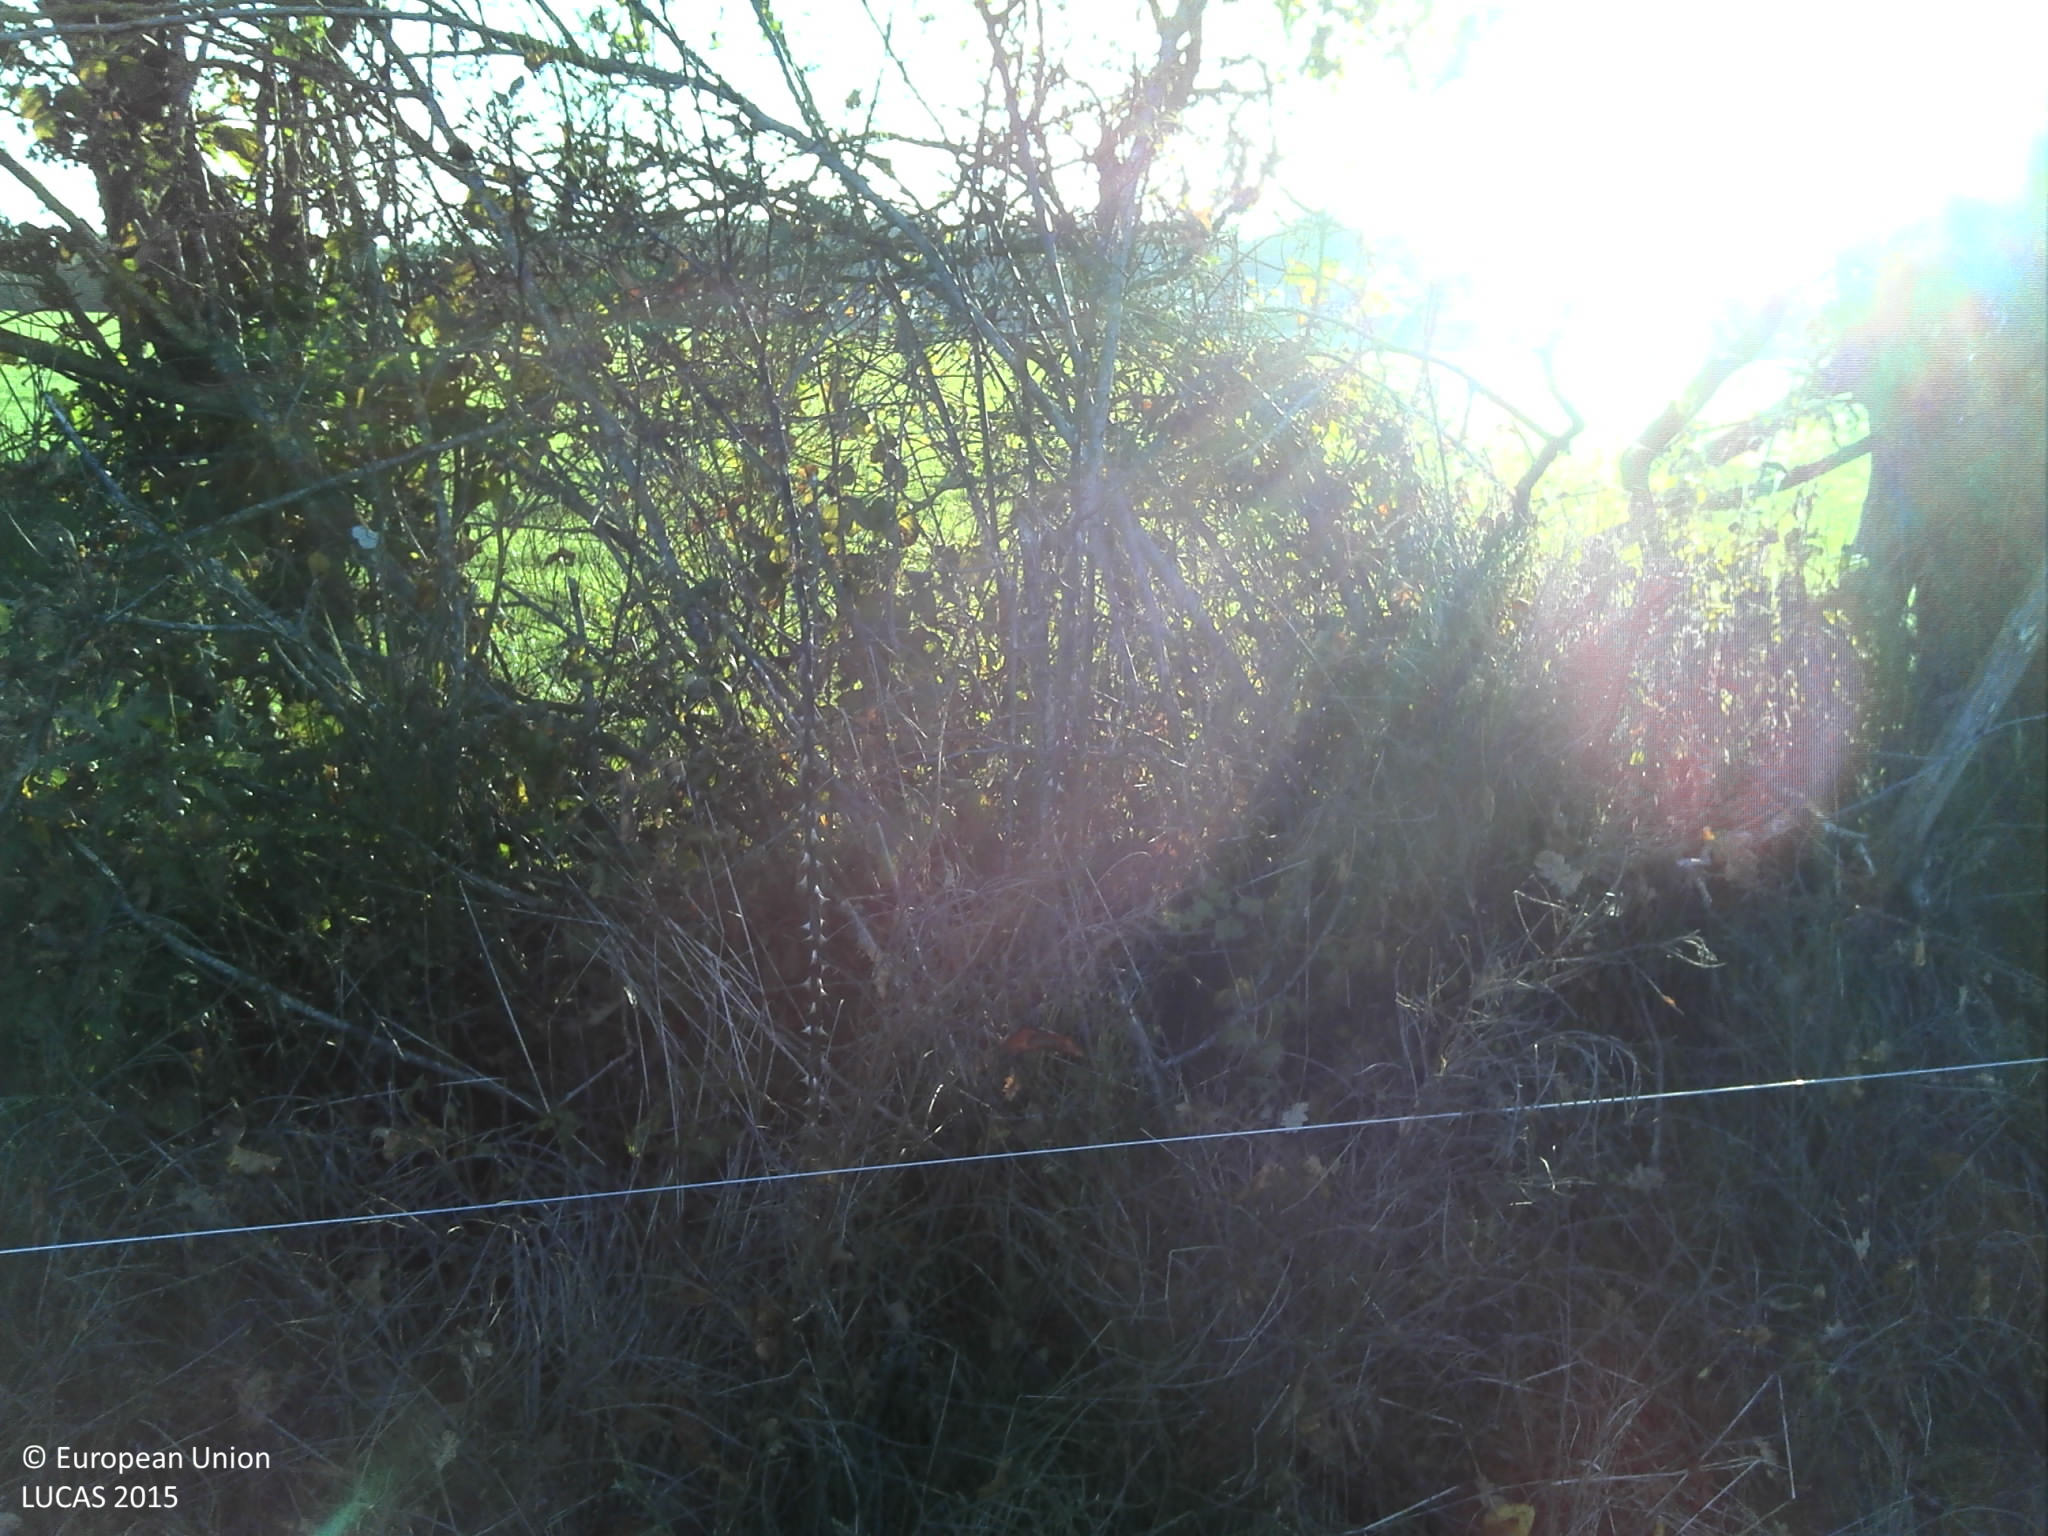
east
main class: Grassland
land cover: Grassland with sparse tree/shrub cover
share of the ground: > 75 %
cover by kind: herbaceous plants 95 %, broadleaved forest trees 5 %
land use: Agriculture (excluding fallow land and kitchen gardens)
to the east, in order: Grassland with sparse tree/shrub cover; Fences; Abandoned hedges; Temporary grasslands; Fences; Broadleaved woodland
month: November
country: FR
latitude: 47.5923
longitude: -1.0622
